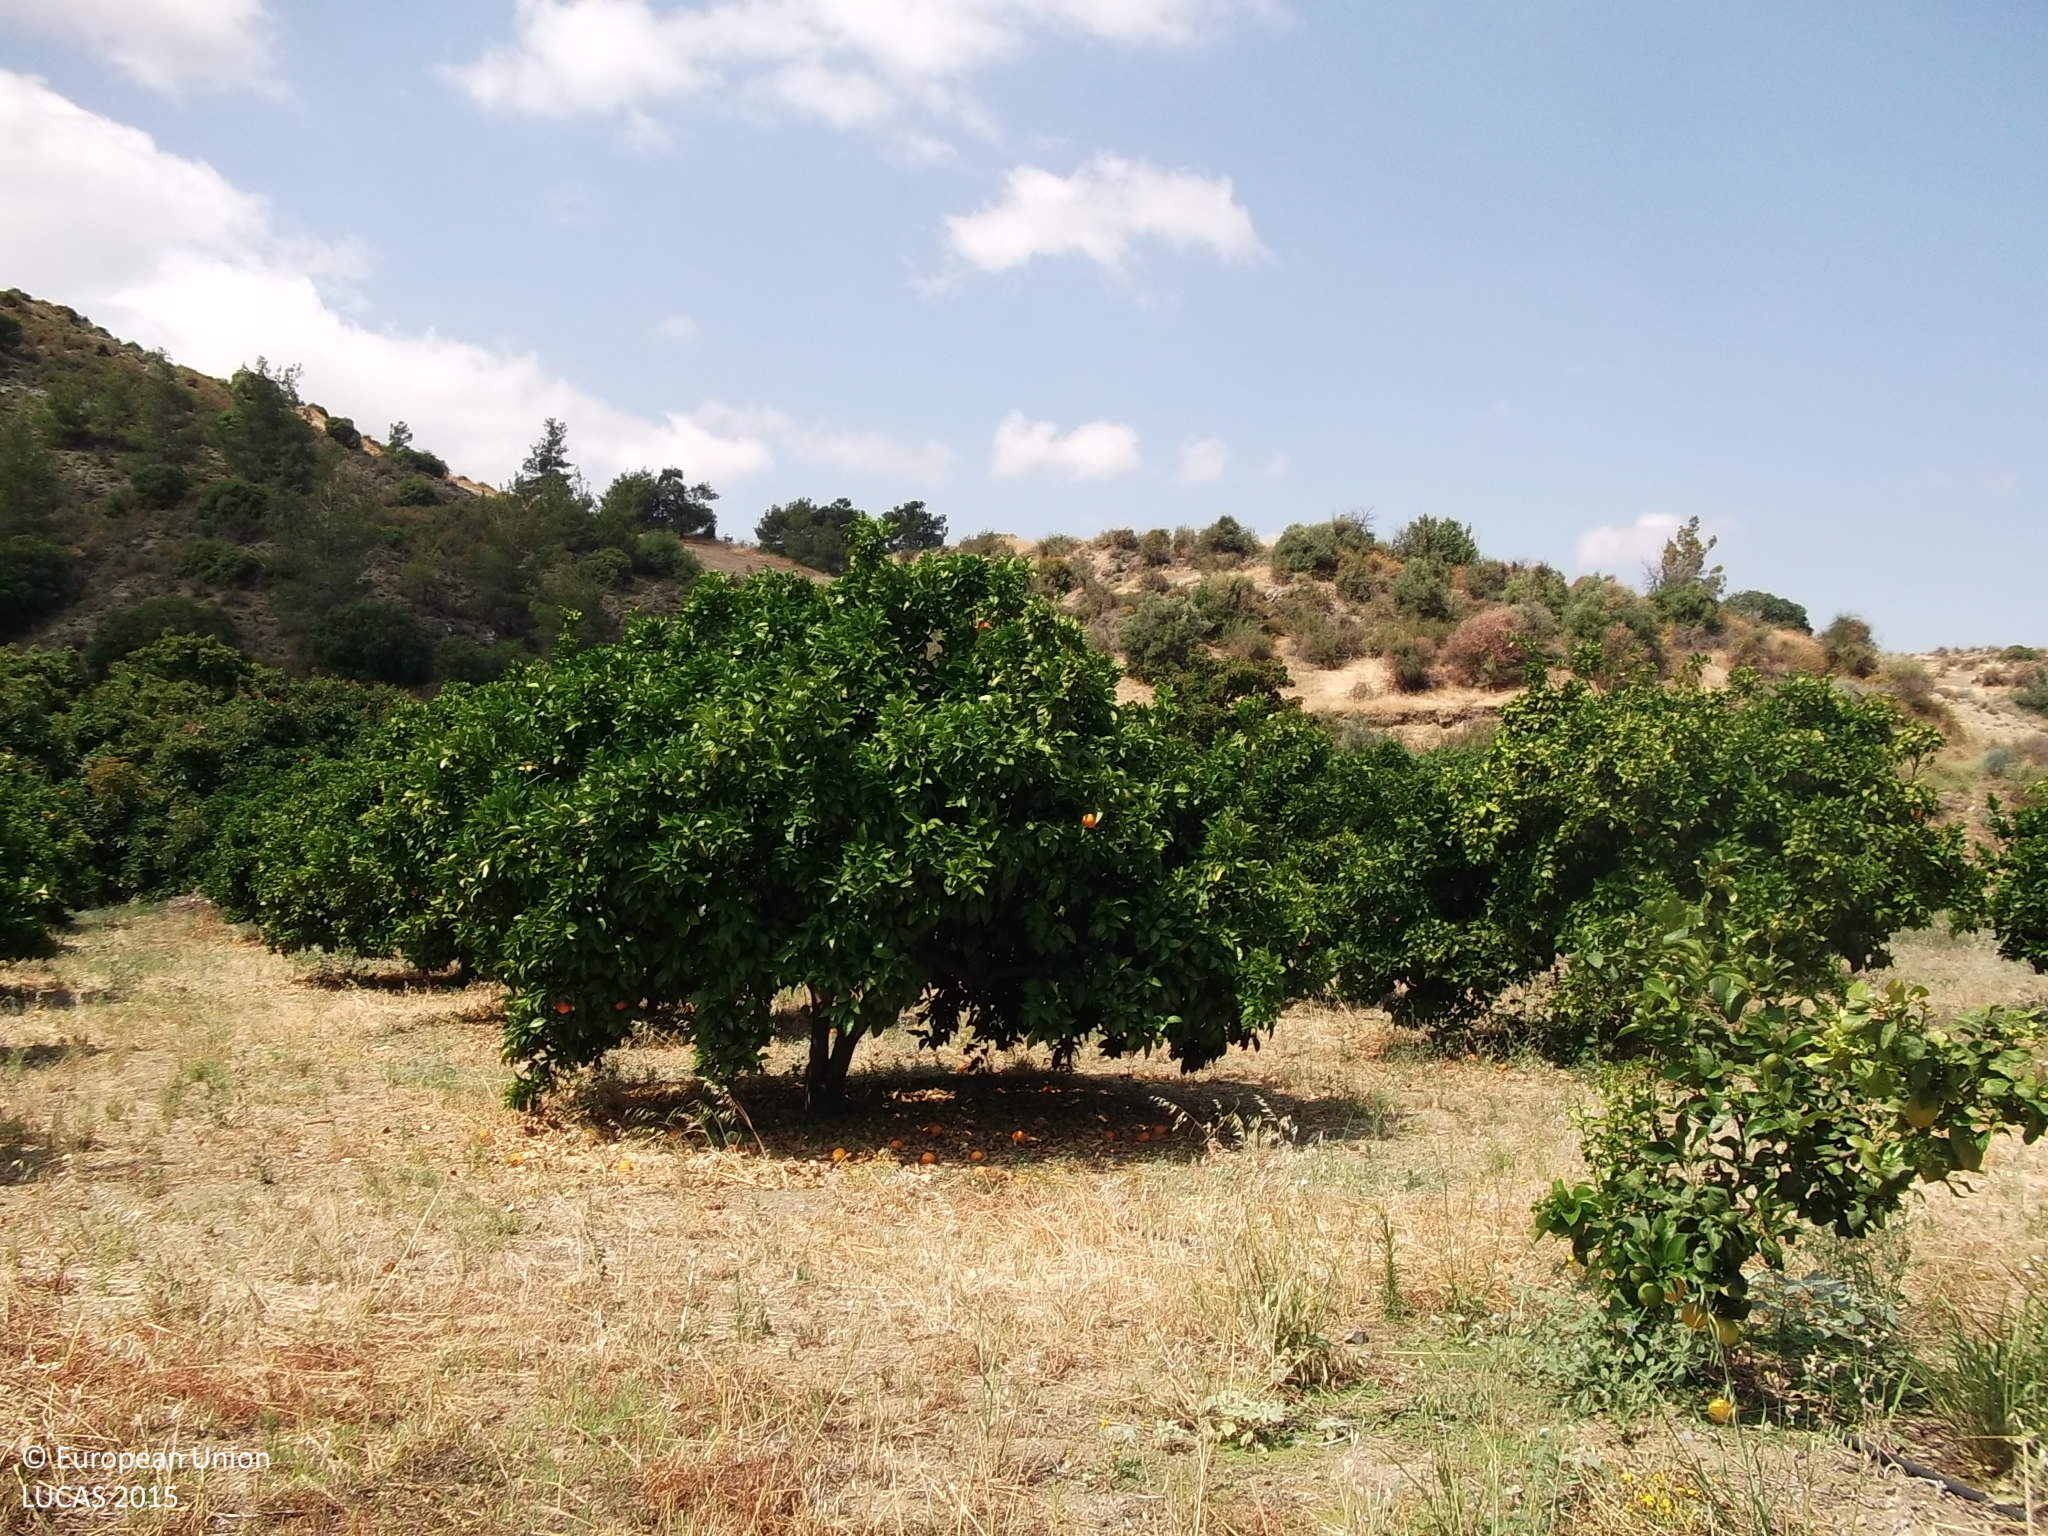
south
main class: Cropland
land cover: Oranges
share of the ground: 25 - 50 %
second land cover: Grassland without tree/shrub cover
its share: 25 - 50 %
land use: Agriculture (excluding fallow land and kitchen gardens)
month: June
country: CY
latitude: 35.0540
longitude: 32.4899
